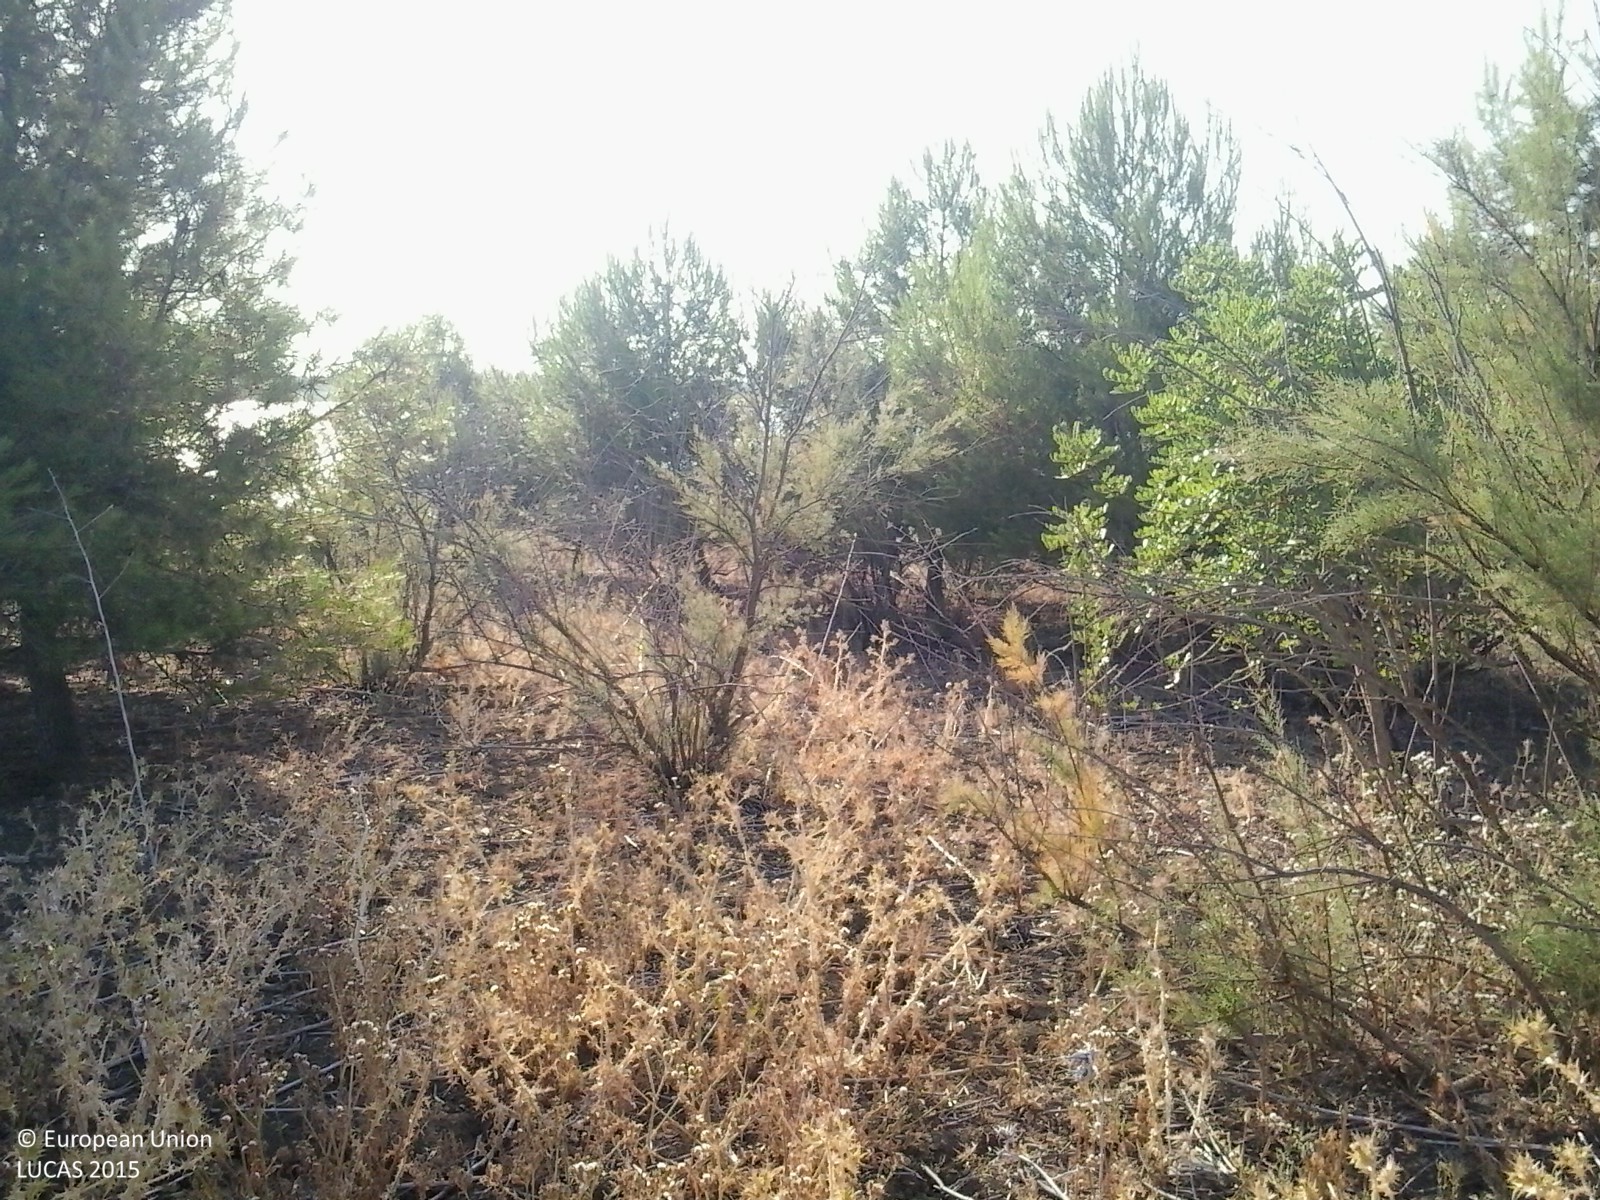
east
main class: Woodland
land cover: Pine dominated coniferous woodland
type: coniferous forest of the mediterranean region
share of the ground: 25 - 50 %
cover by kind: shrubs 50 %, coniferous forest trees 30 %, herbaceous plants 20 %
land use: Forestry
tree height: > 5 m
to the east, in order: Pine dominated coniferous woodland; Shrubland without tree cover; Grassland without tree/shrub cover; Inland fresh water bodies
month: July
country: ES
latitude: 36.9481
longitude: -6.0403
